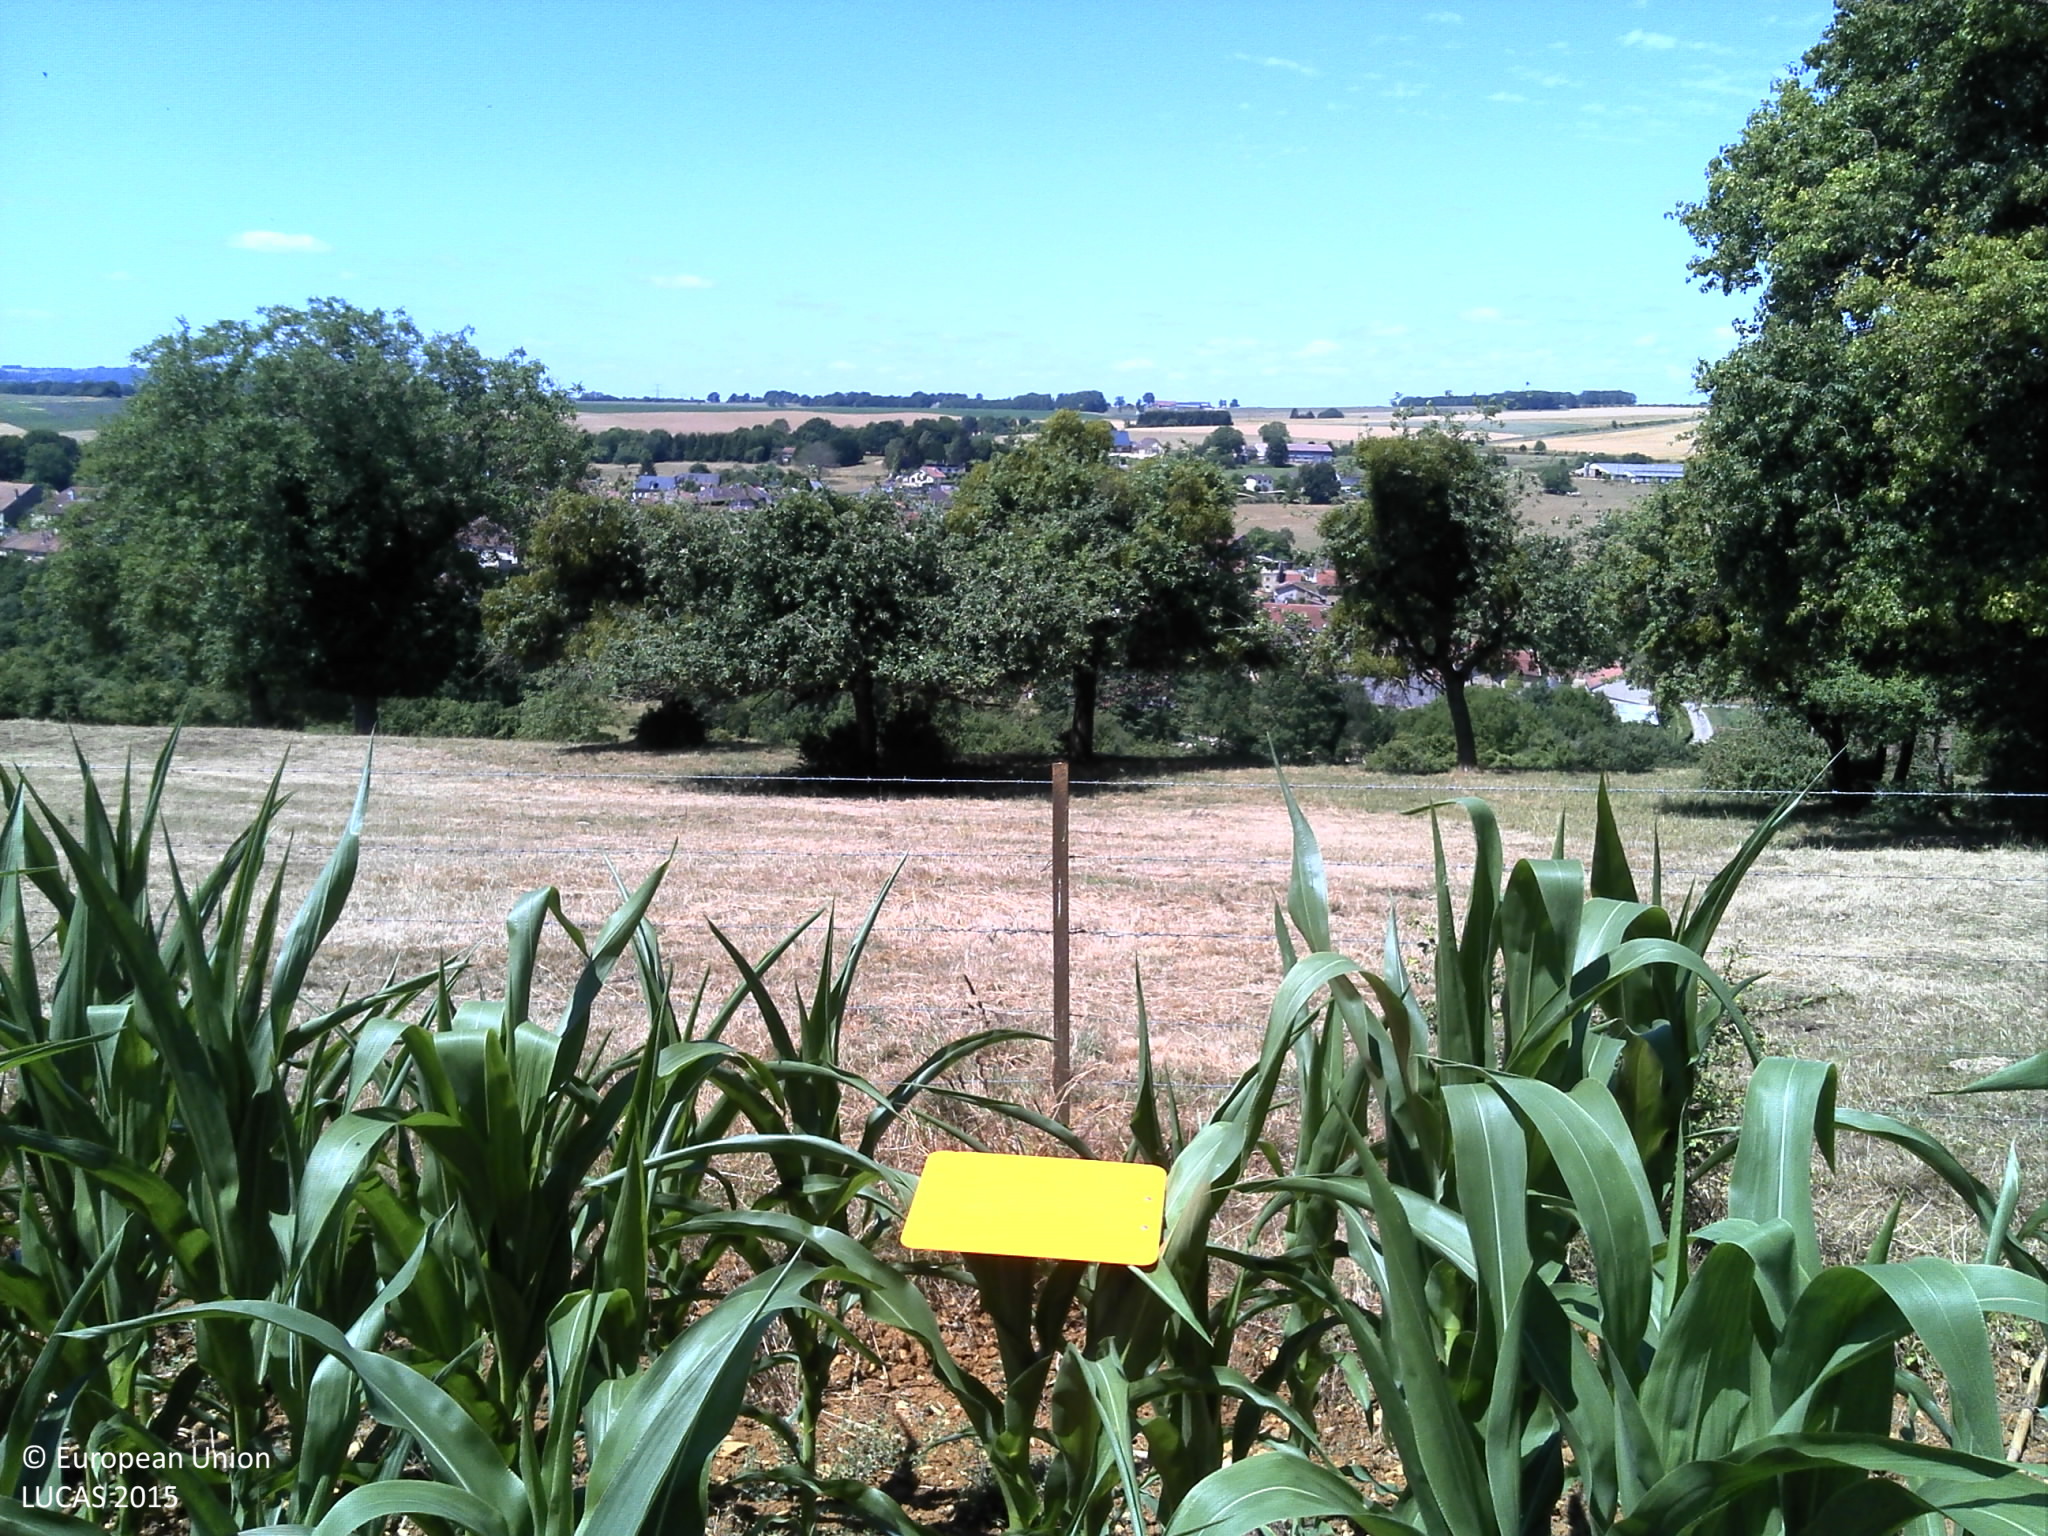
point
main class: Cropland
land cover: Maize
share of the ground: > 75 %
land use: Agriculture (excluding fallow land and kitchen gardens)
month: June
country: FR
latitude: 49.5369
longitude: 5.0645
